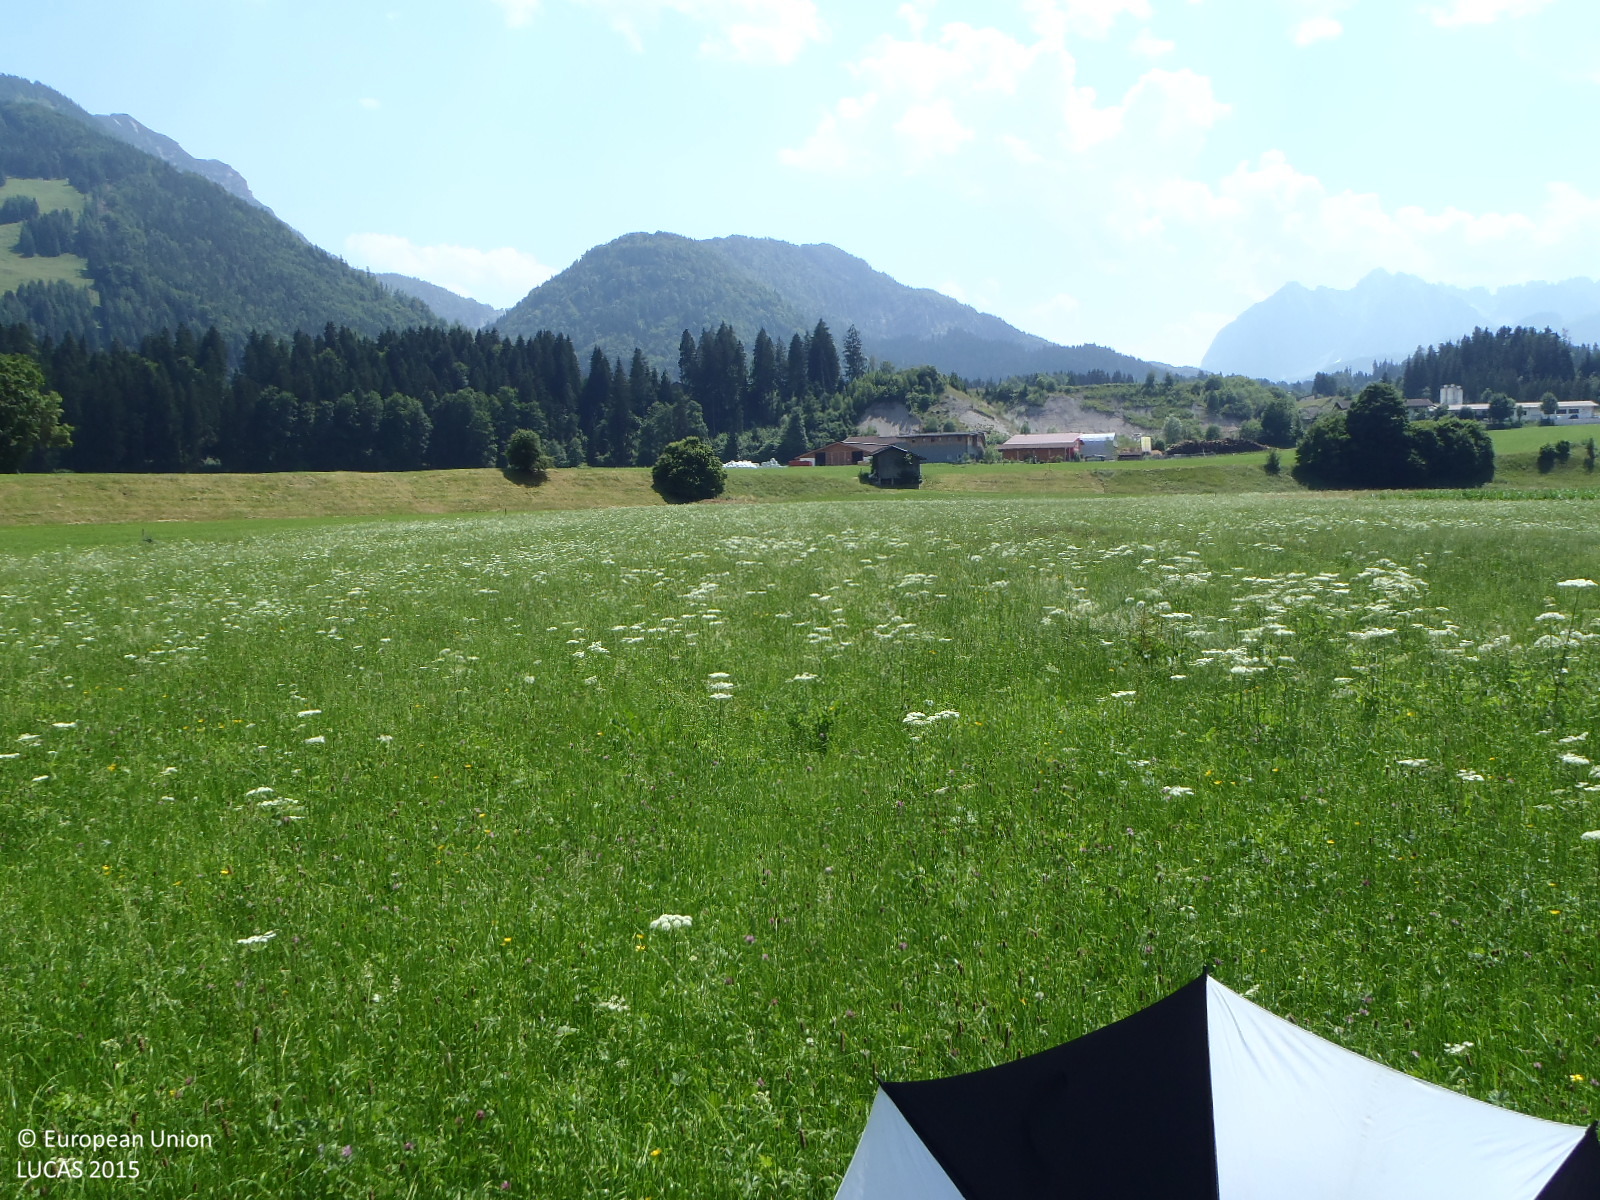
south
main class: Grassland
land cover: Grassland without tree/shrub cover
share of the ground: > 75 %
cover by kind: herbaceous plants 100 %
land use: Agriculture (excluding fallow land and kitchen gardens)
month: July
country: AT
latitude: 47.6571
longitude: 12.4085
